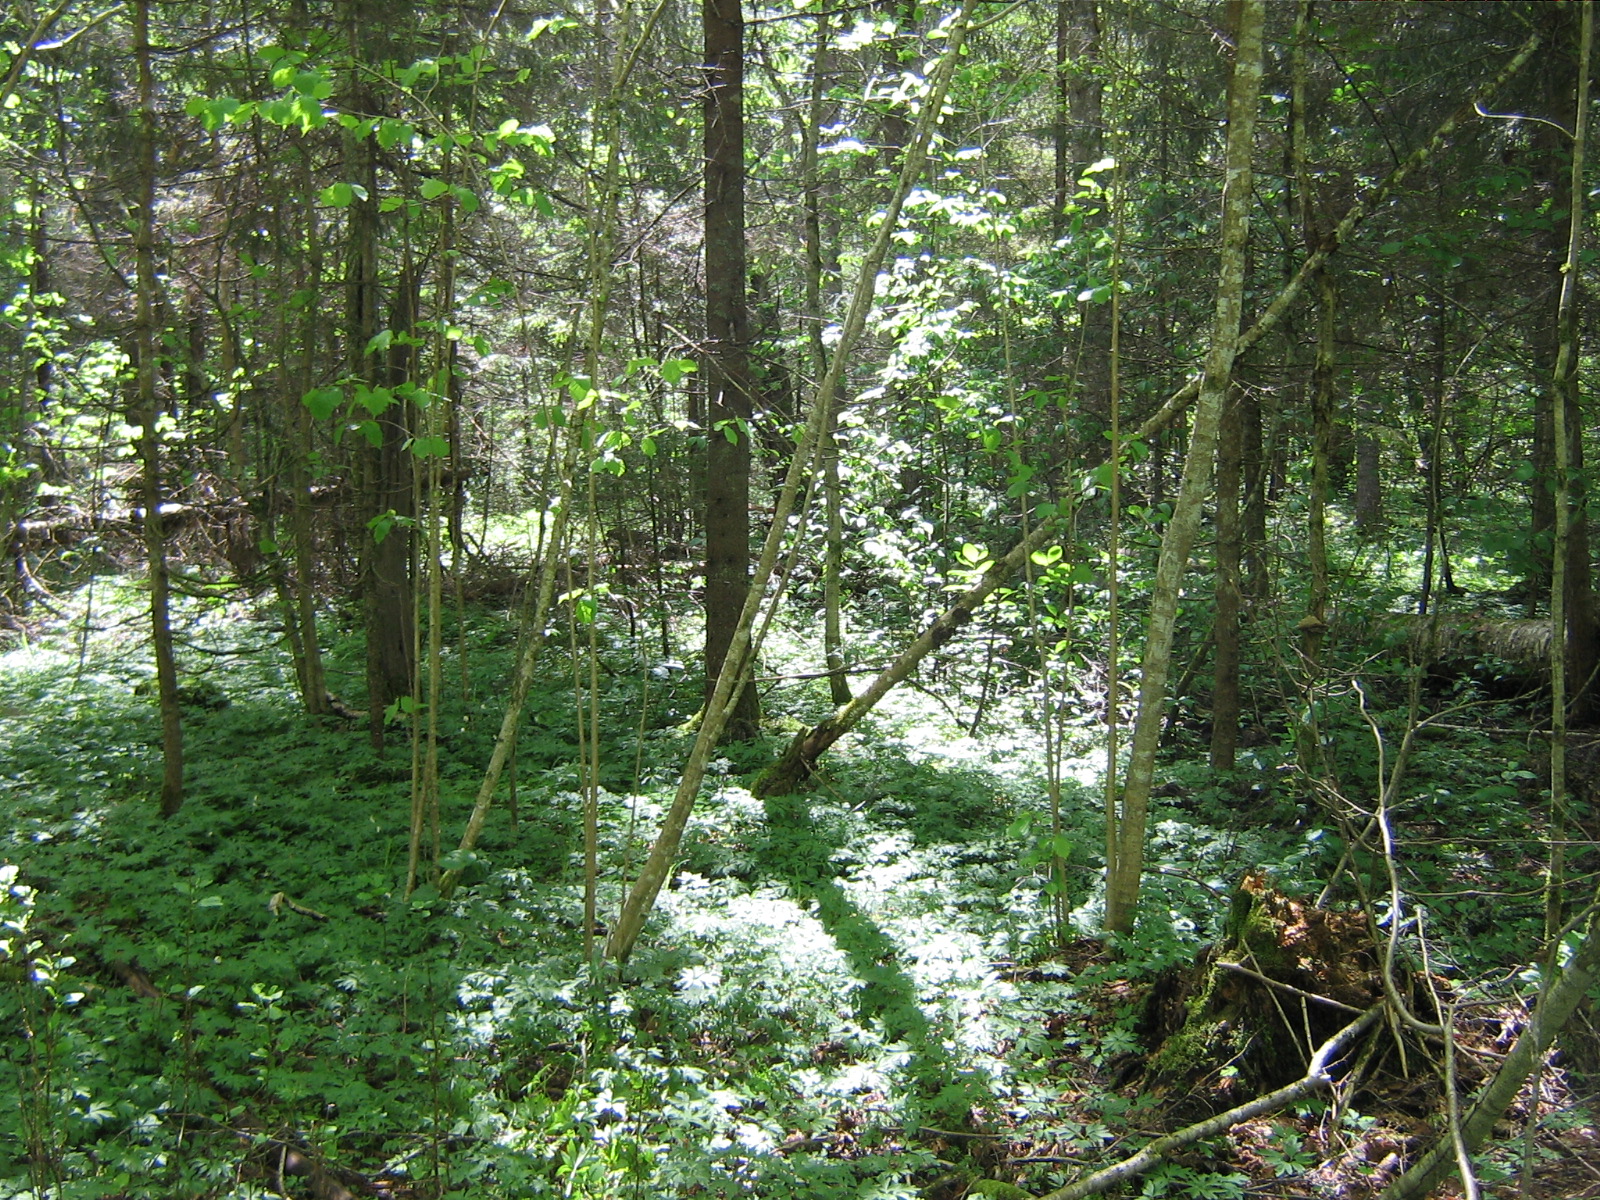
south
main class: Woodland
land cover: Broadleaved woodland
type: non-riverine alder, birch or aspen forest
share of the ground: > 75 %
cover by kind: broadleaved forest trees 100 %
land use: Forestry
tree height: > 5 m
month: May
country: LV
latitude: 57.0237
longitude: 25.4529
